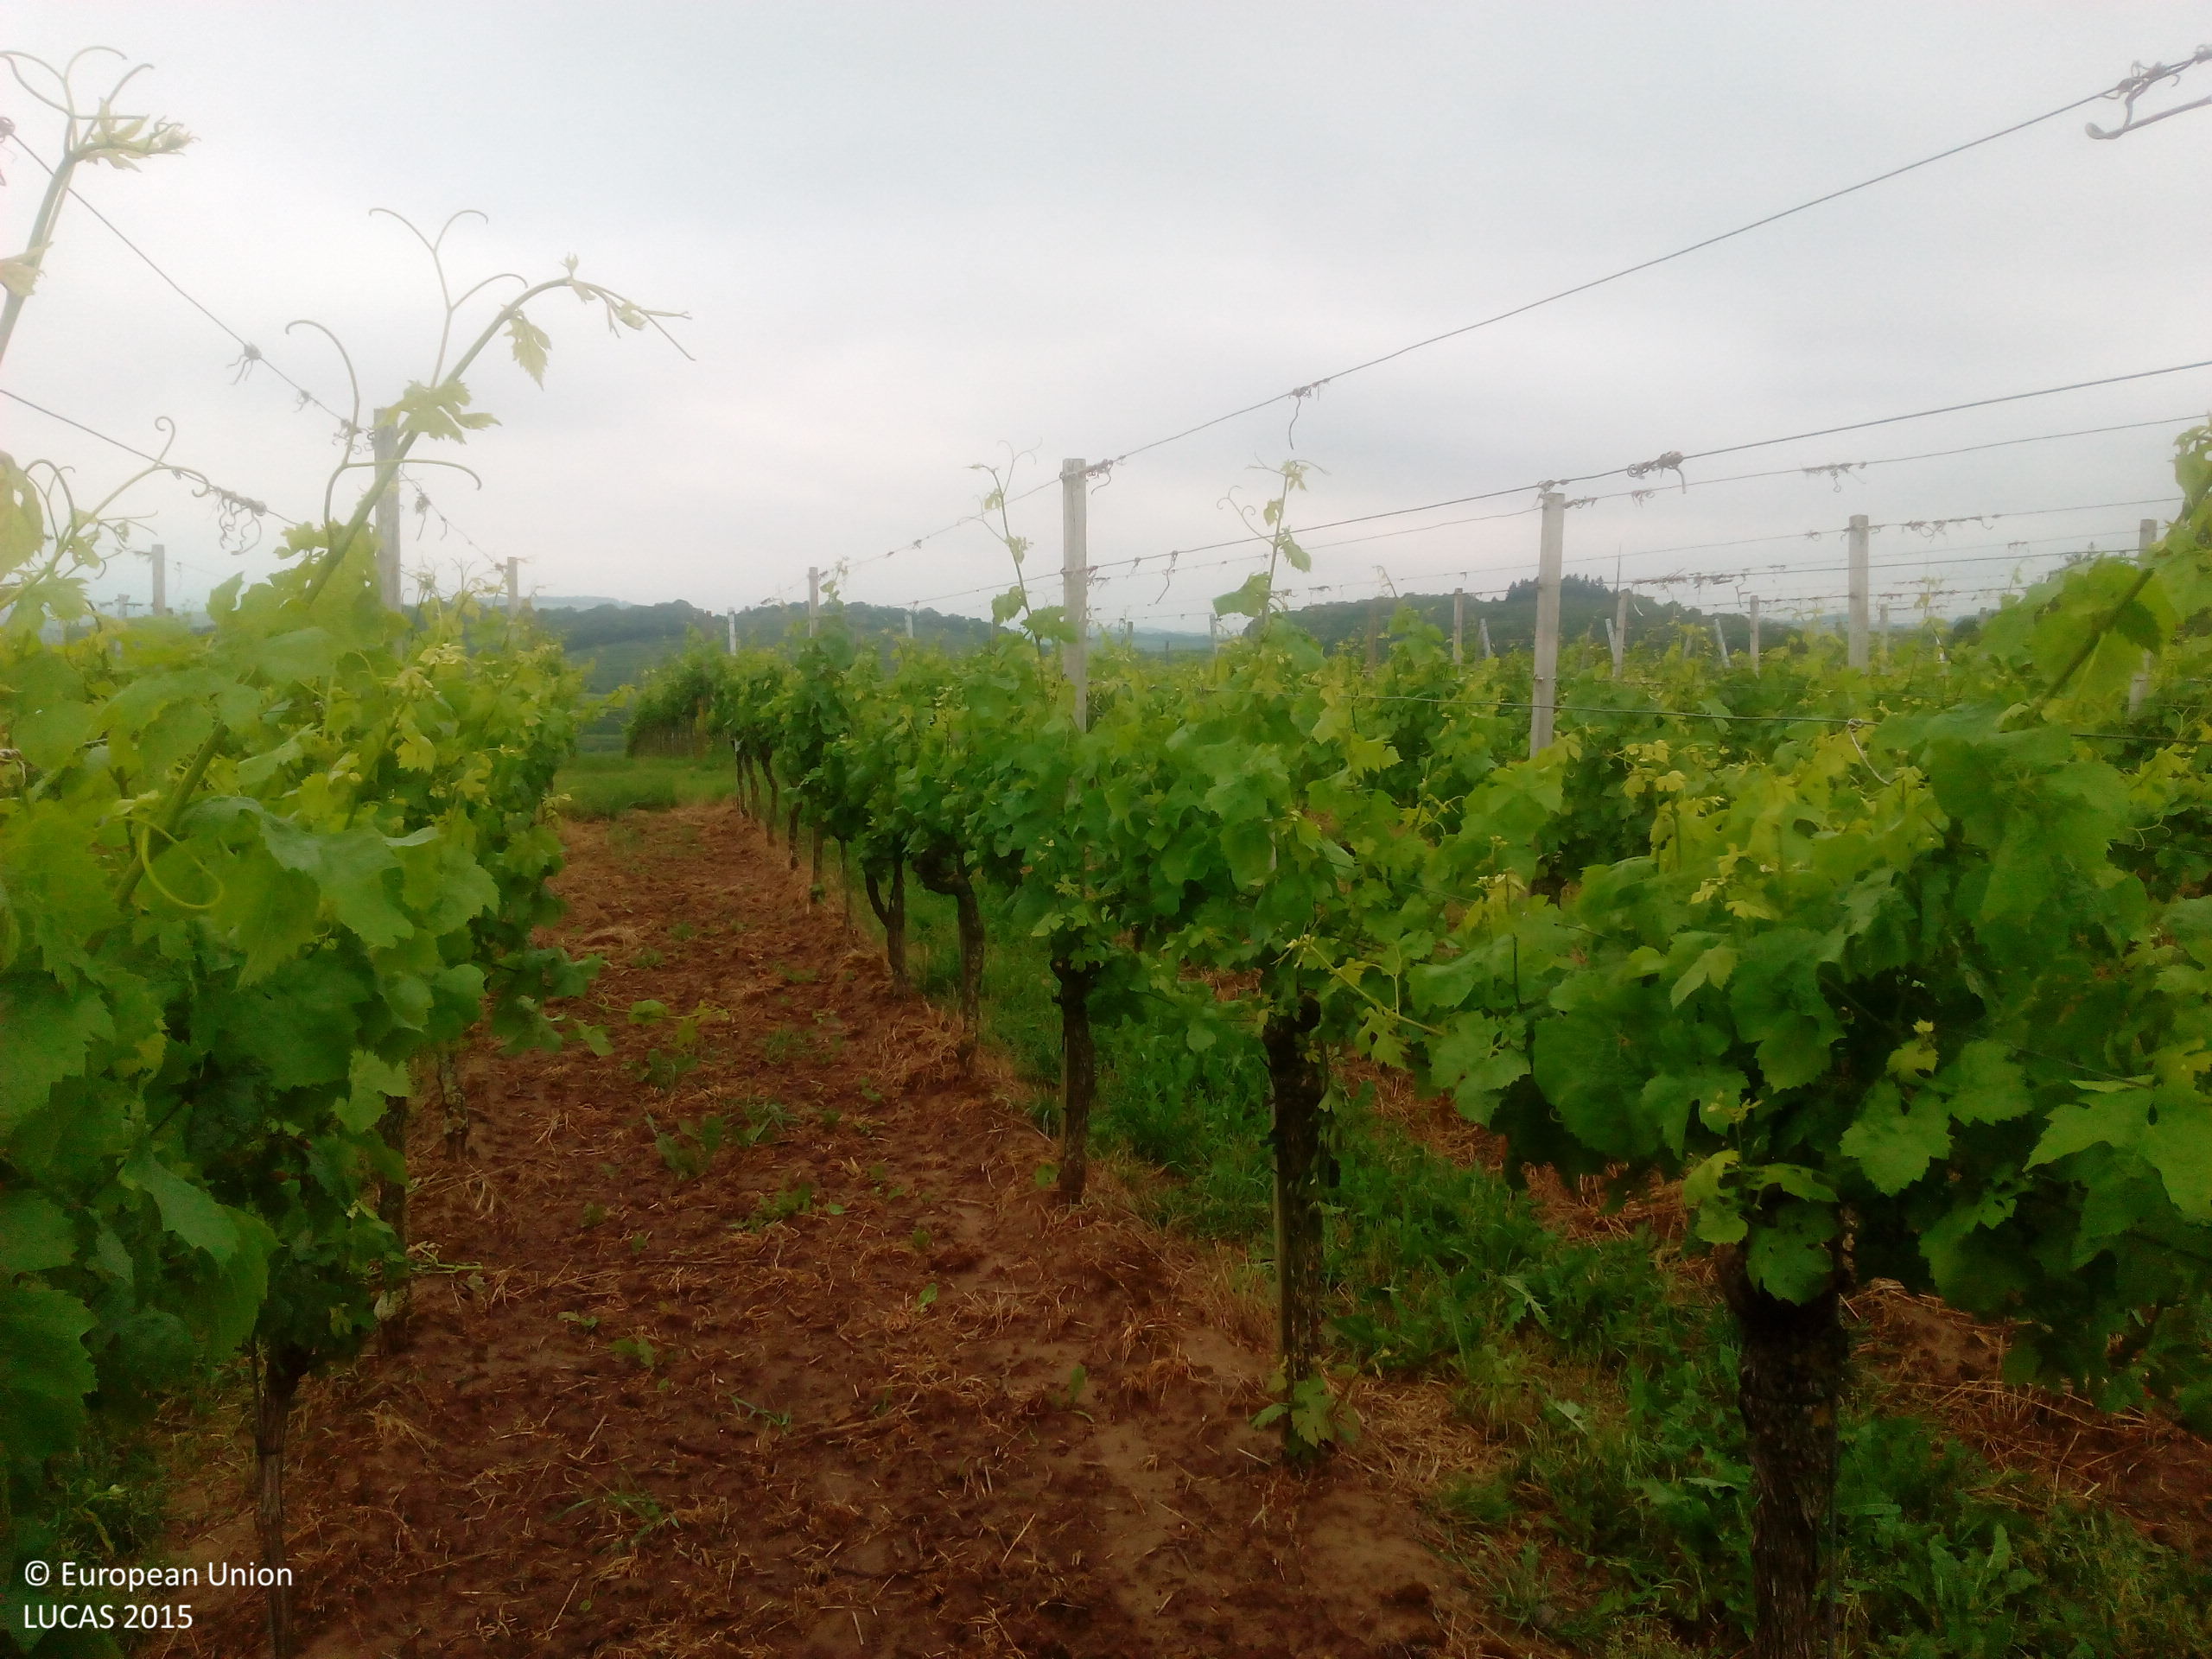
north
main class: Cropland
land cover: Vineyards
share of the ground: 50 - 75 %
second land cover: Grassland without tree/shrub cover
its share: 25 - 50 %
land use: Agriculture (excluding fallow land and kitchen gardens)
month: June
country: DE
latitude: 48.0720
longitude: 7.6256
